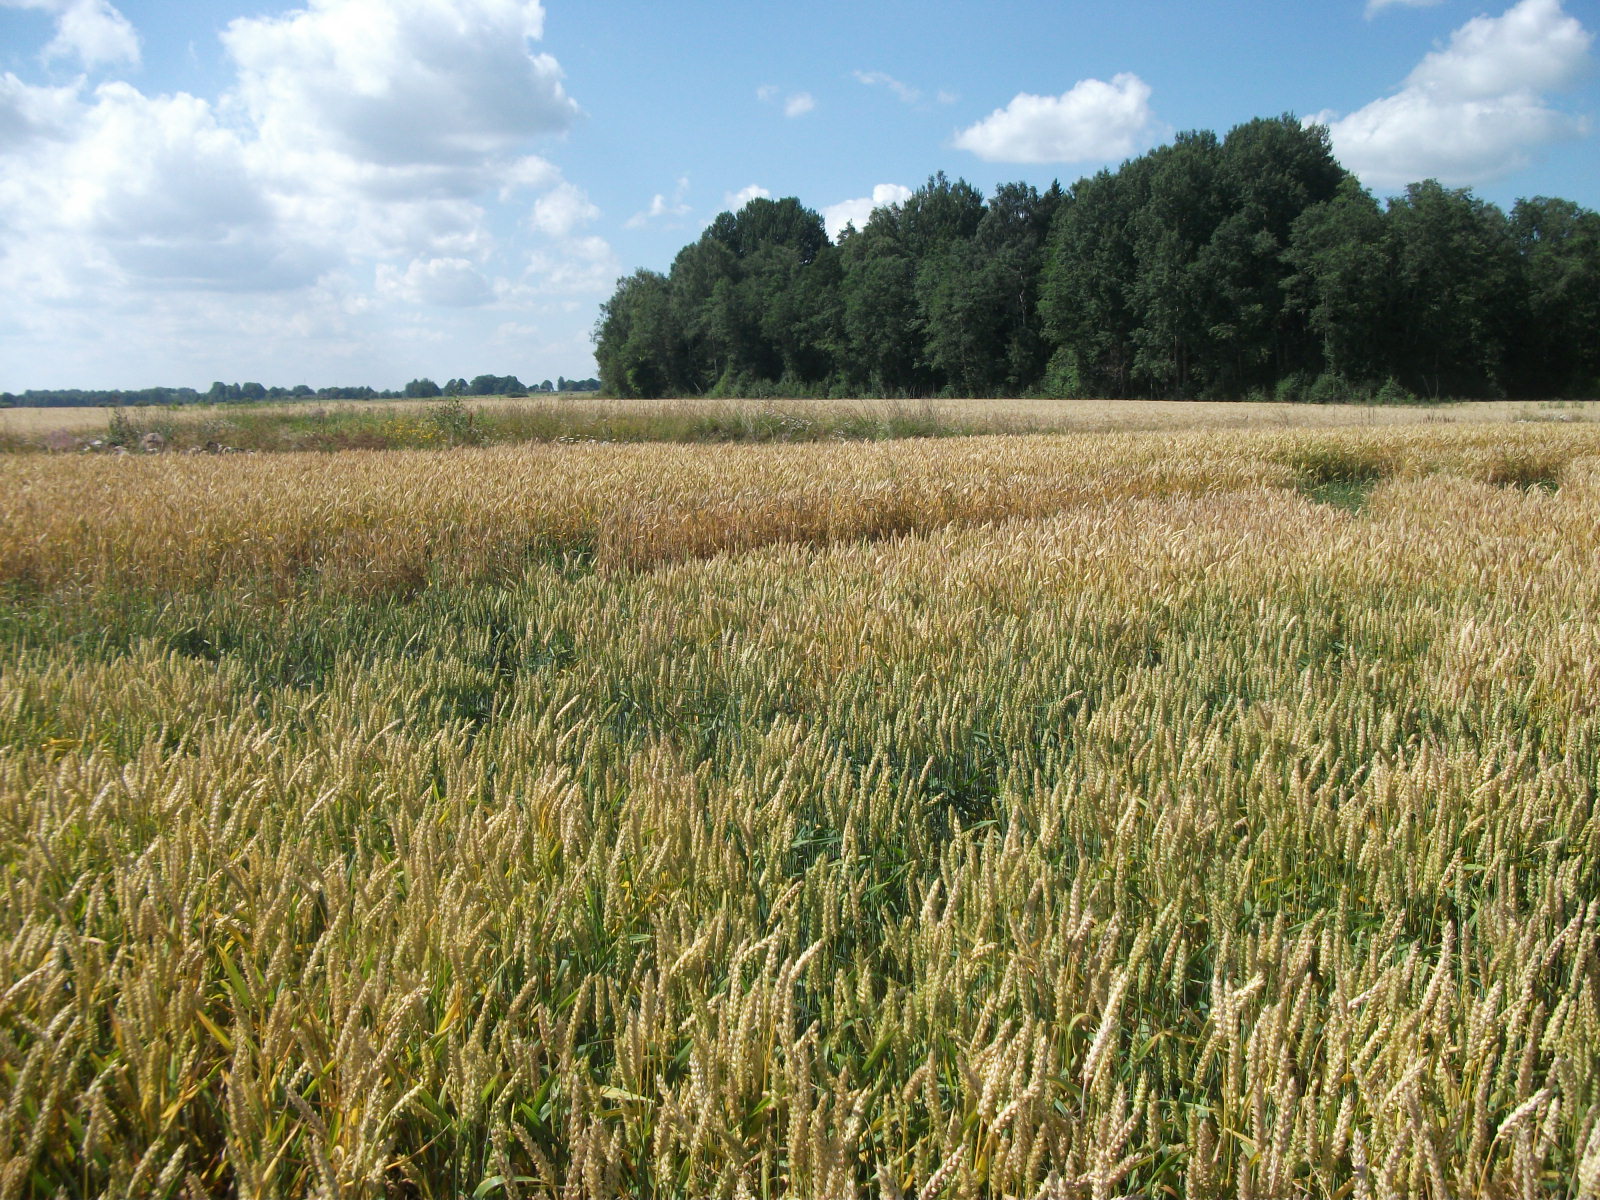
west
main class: Cropland
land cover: Common wheat
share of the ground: > 75 %
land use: Agriculture (excluding fallow land and kitchen gardens)
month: August
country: LV
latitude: 57.0714
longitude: 26.6946
